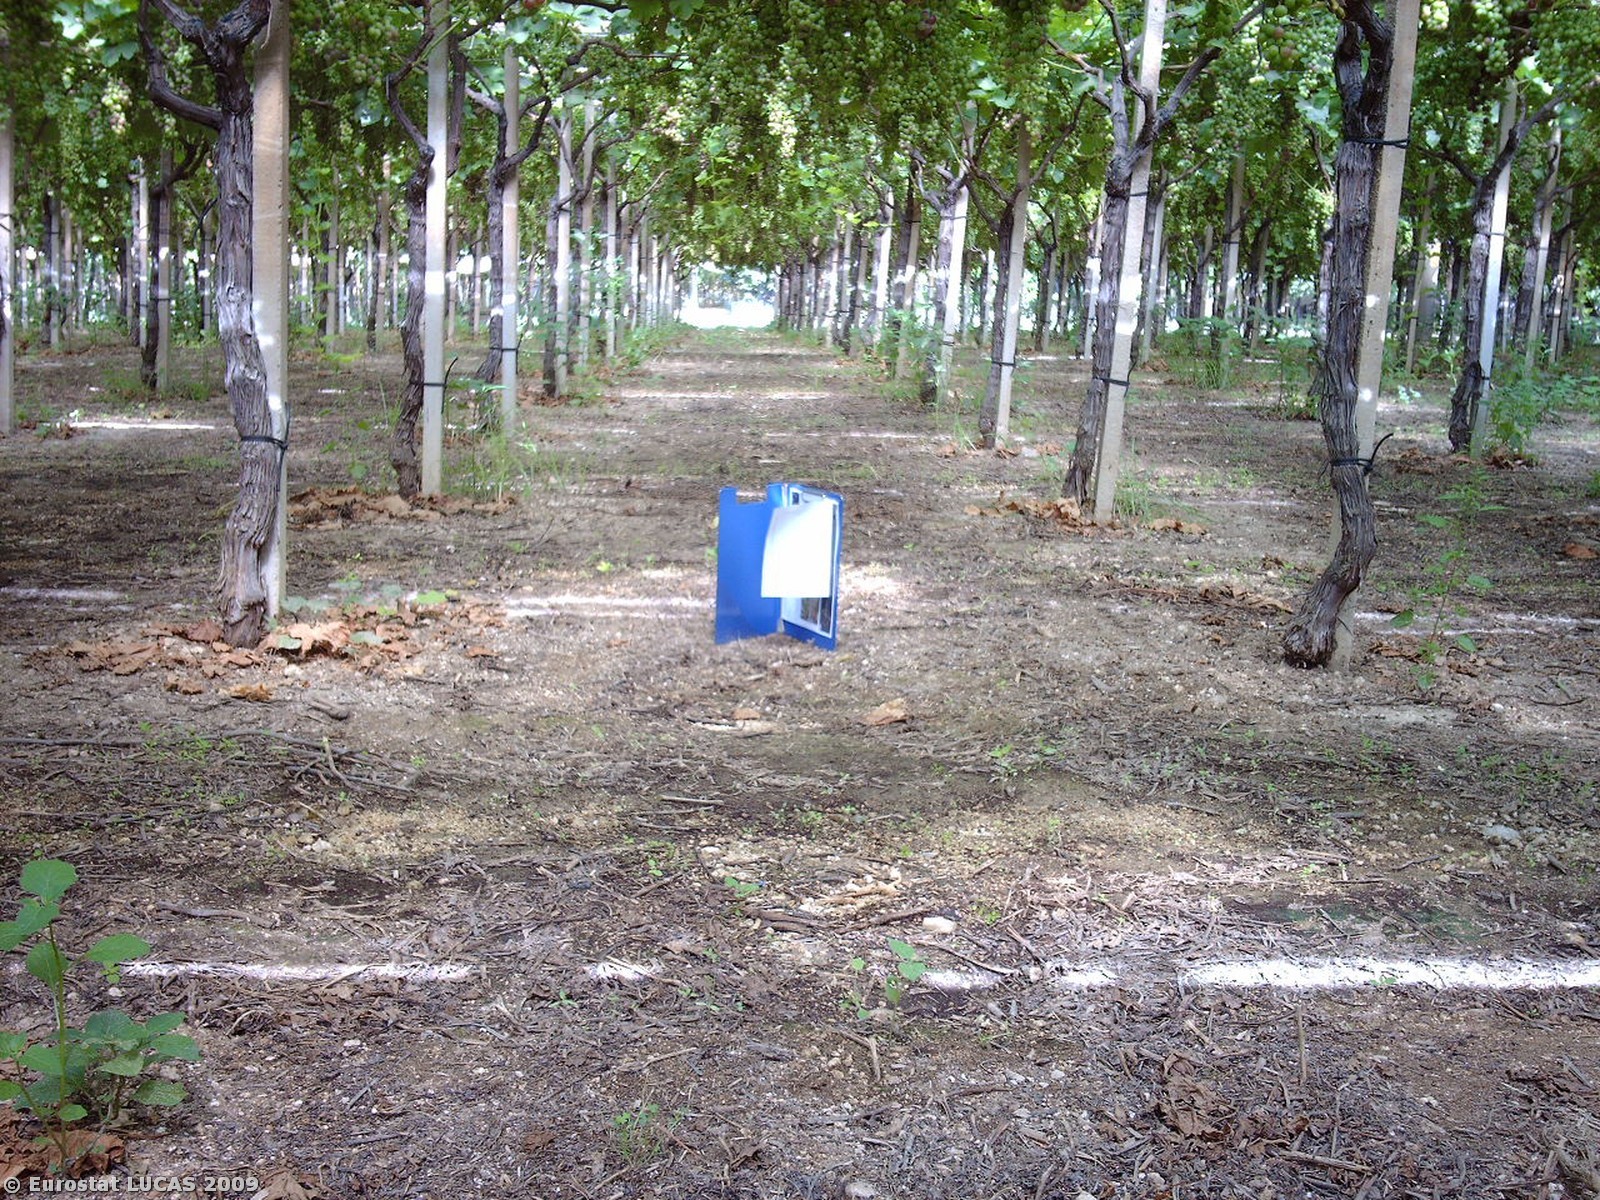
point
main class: Cropland
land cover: Vineyards
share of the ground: 50 - 75 %
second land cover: Bare land
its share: 50 - 75 %
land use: Agriculture (excluding fallow land and kitchen gardens)
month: July
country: IT
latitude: 41.0363
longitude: 16.9613
